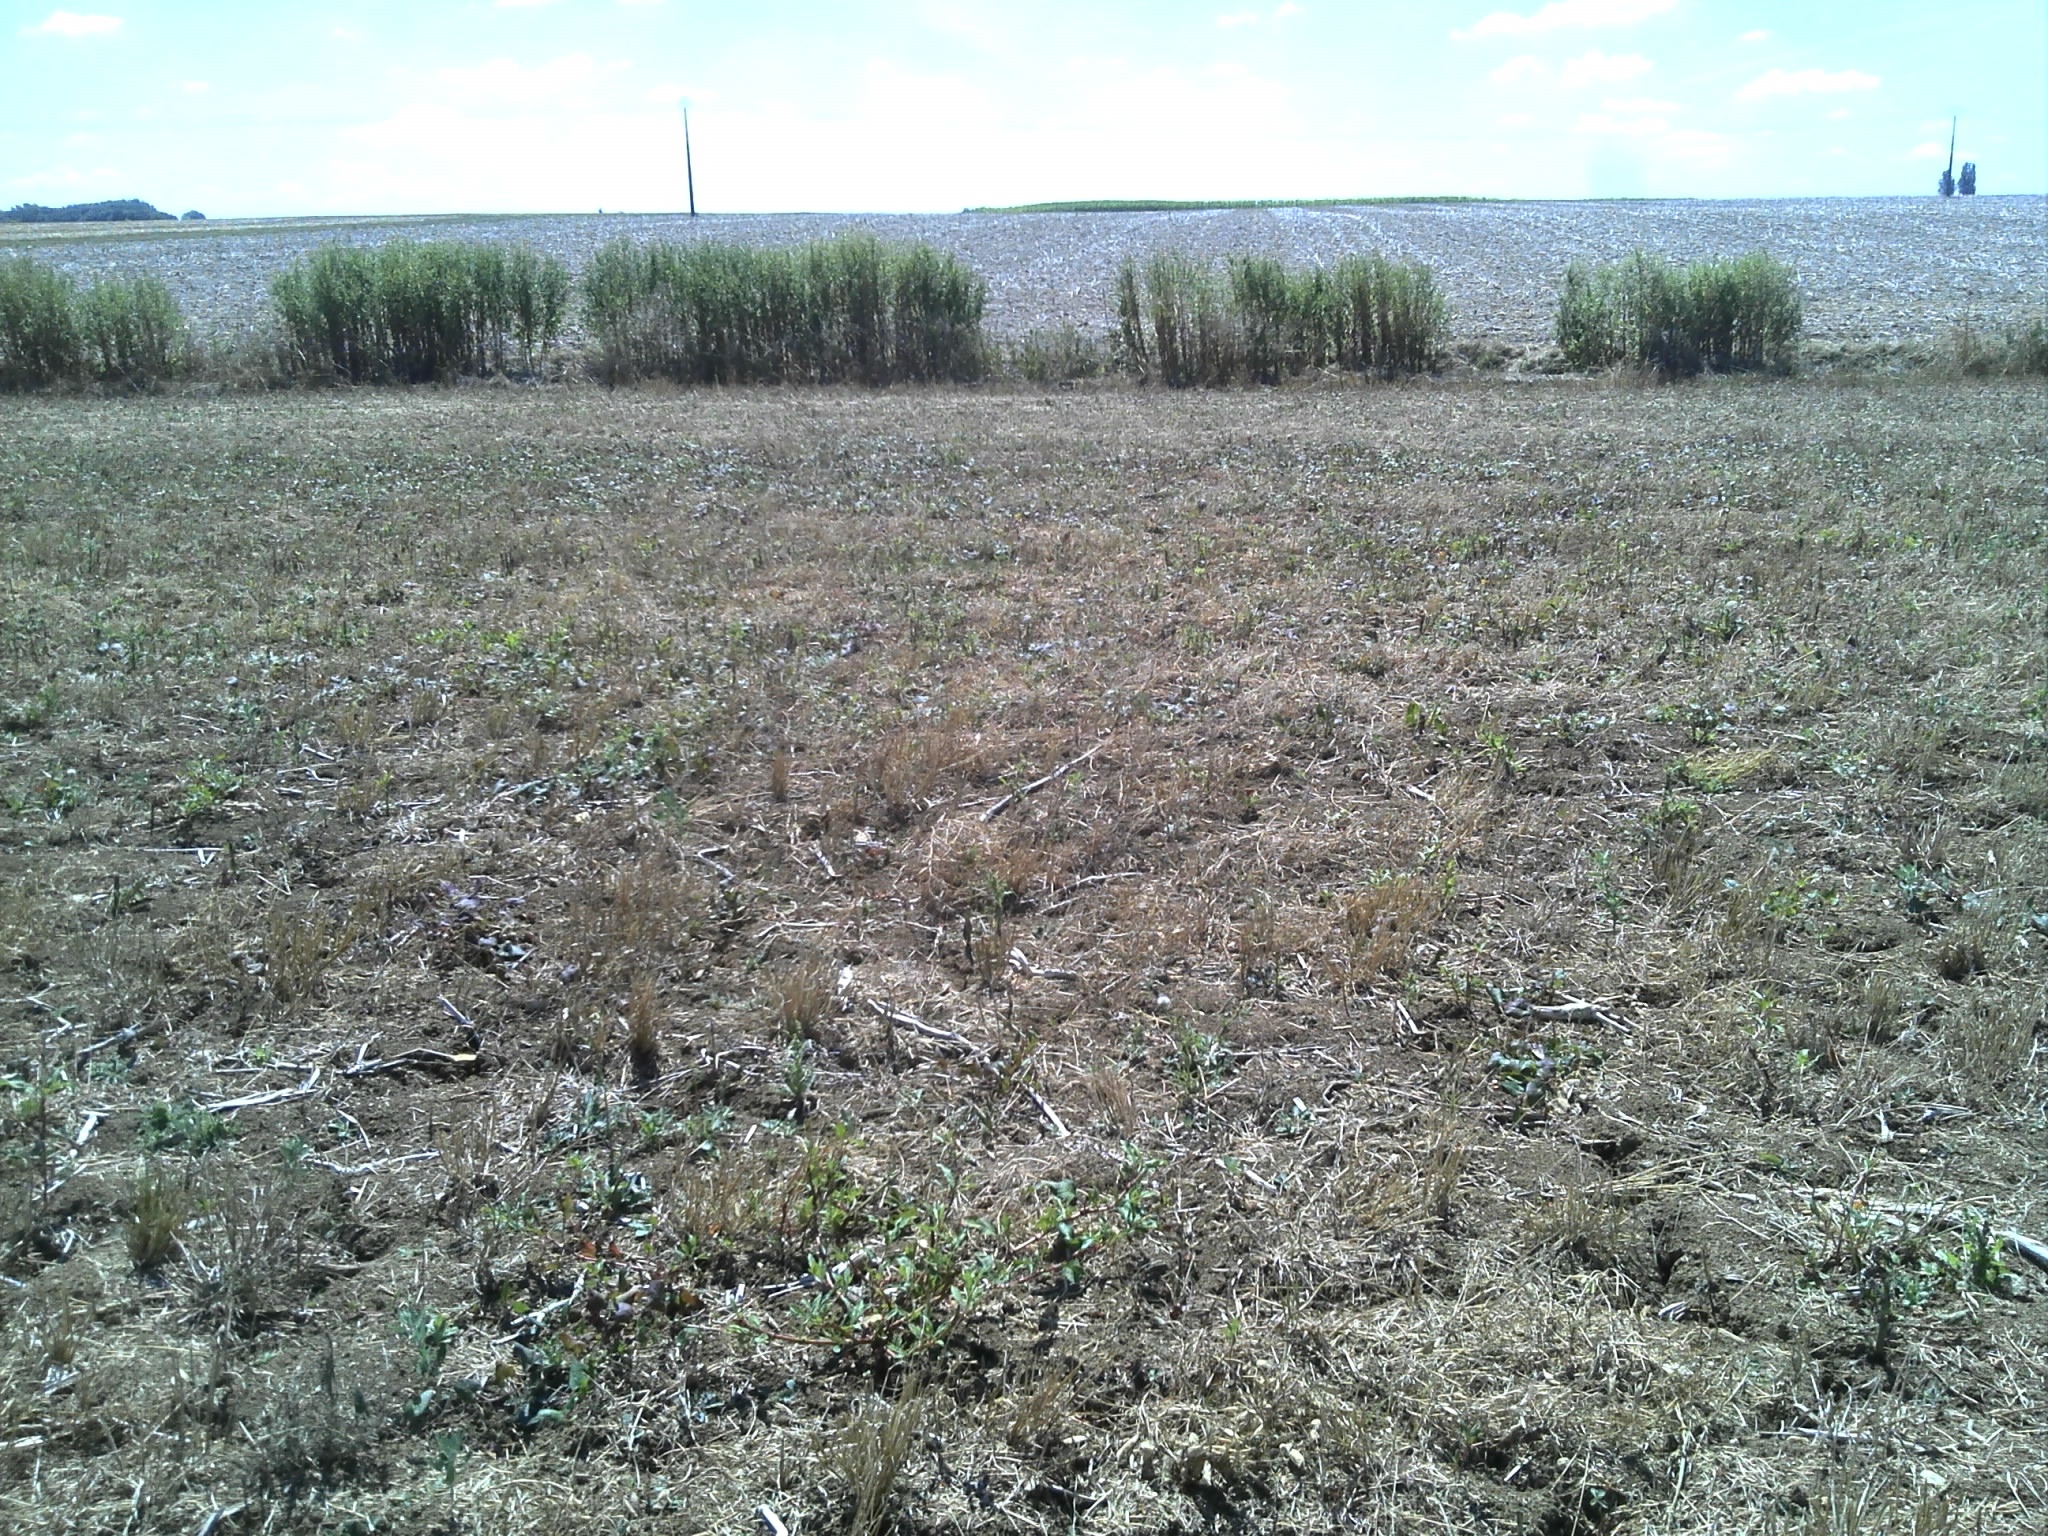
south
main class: Cropland
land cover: Dry pulses
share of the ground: 25 - 50 %
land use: Agriculture (excluding fallow land and kitchen gardens)
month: August
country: FR
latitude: 46.9507
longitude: 1.4605
